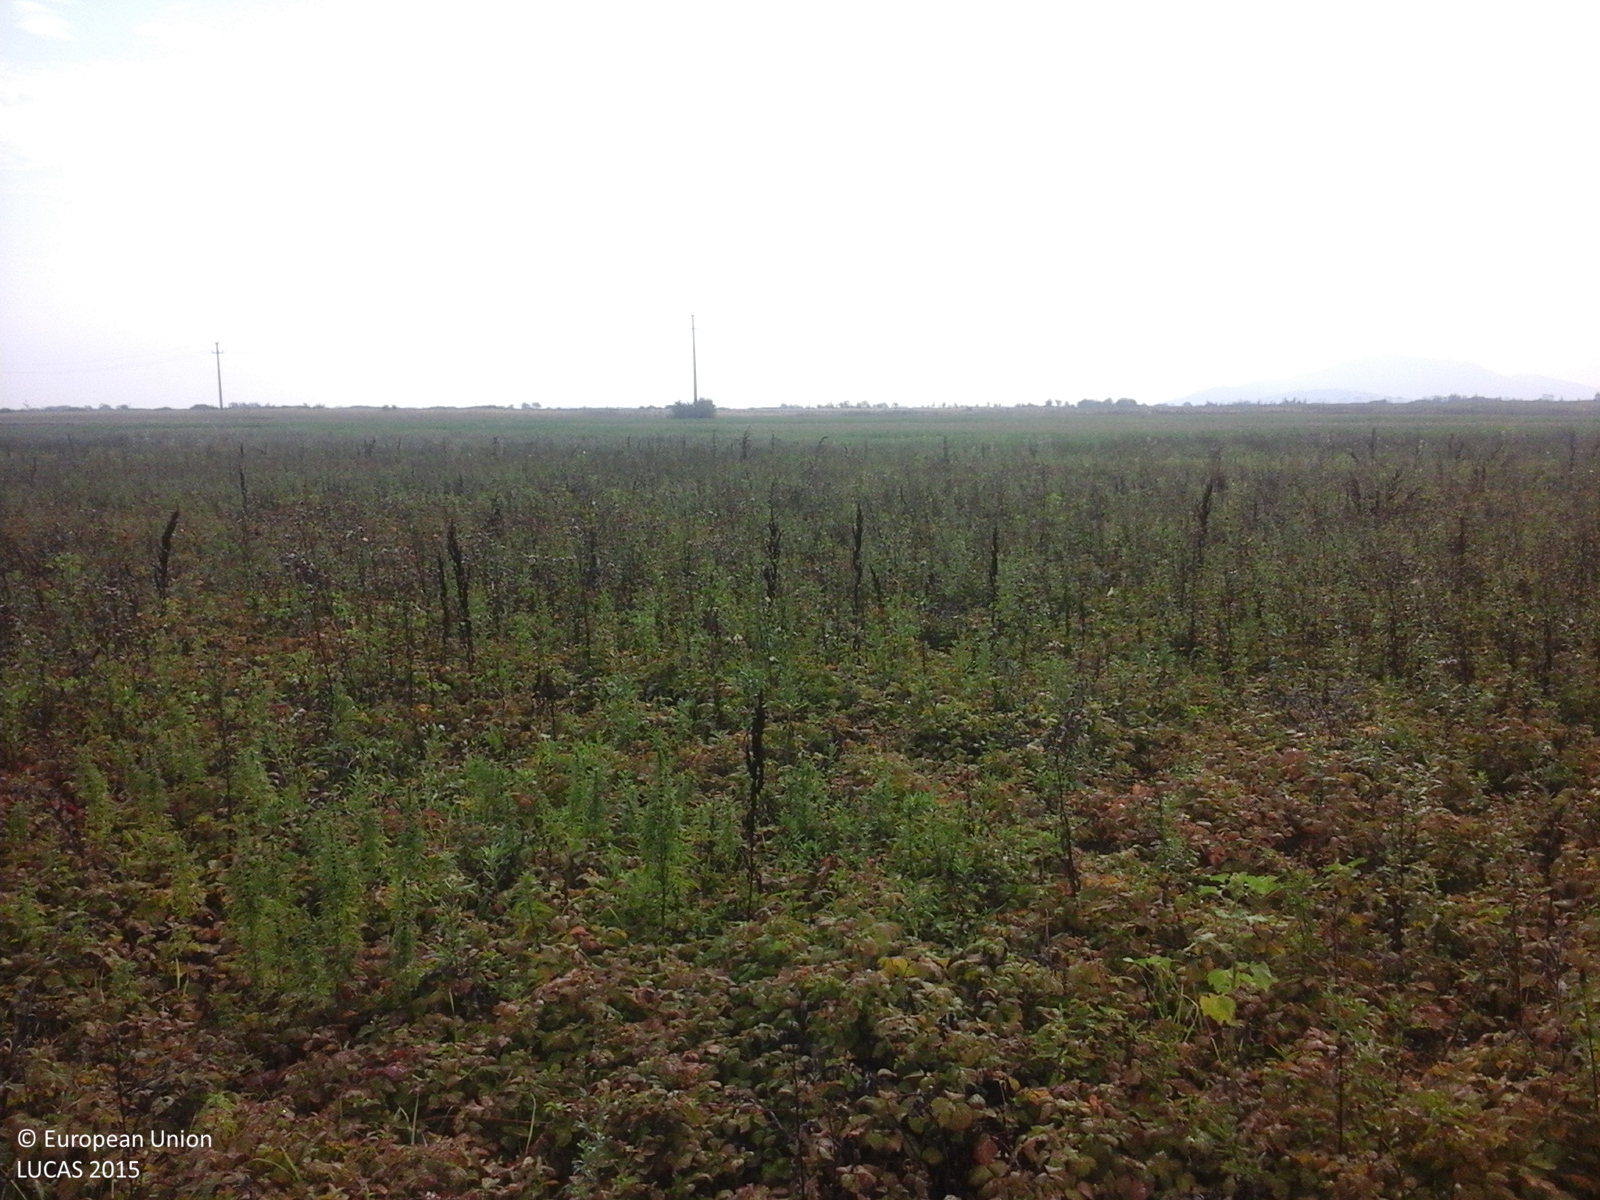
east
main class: Grassland
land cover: Spontaneously vegetated surfaces
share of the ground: > 75 %
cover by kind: herbaceous plants 100 %
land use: Fallow land
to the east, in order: Spontaneously vegetated surfaces; Lucerne; Maize; Lucerne; Electric lines; Lucerne; Grassland without tree/shrub cover; Spontaneously vegetated surfaces; Common wheat; Grass margins; Tracks
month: August
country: RO
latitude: 46.4122
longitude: 21.7357
